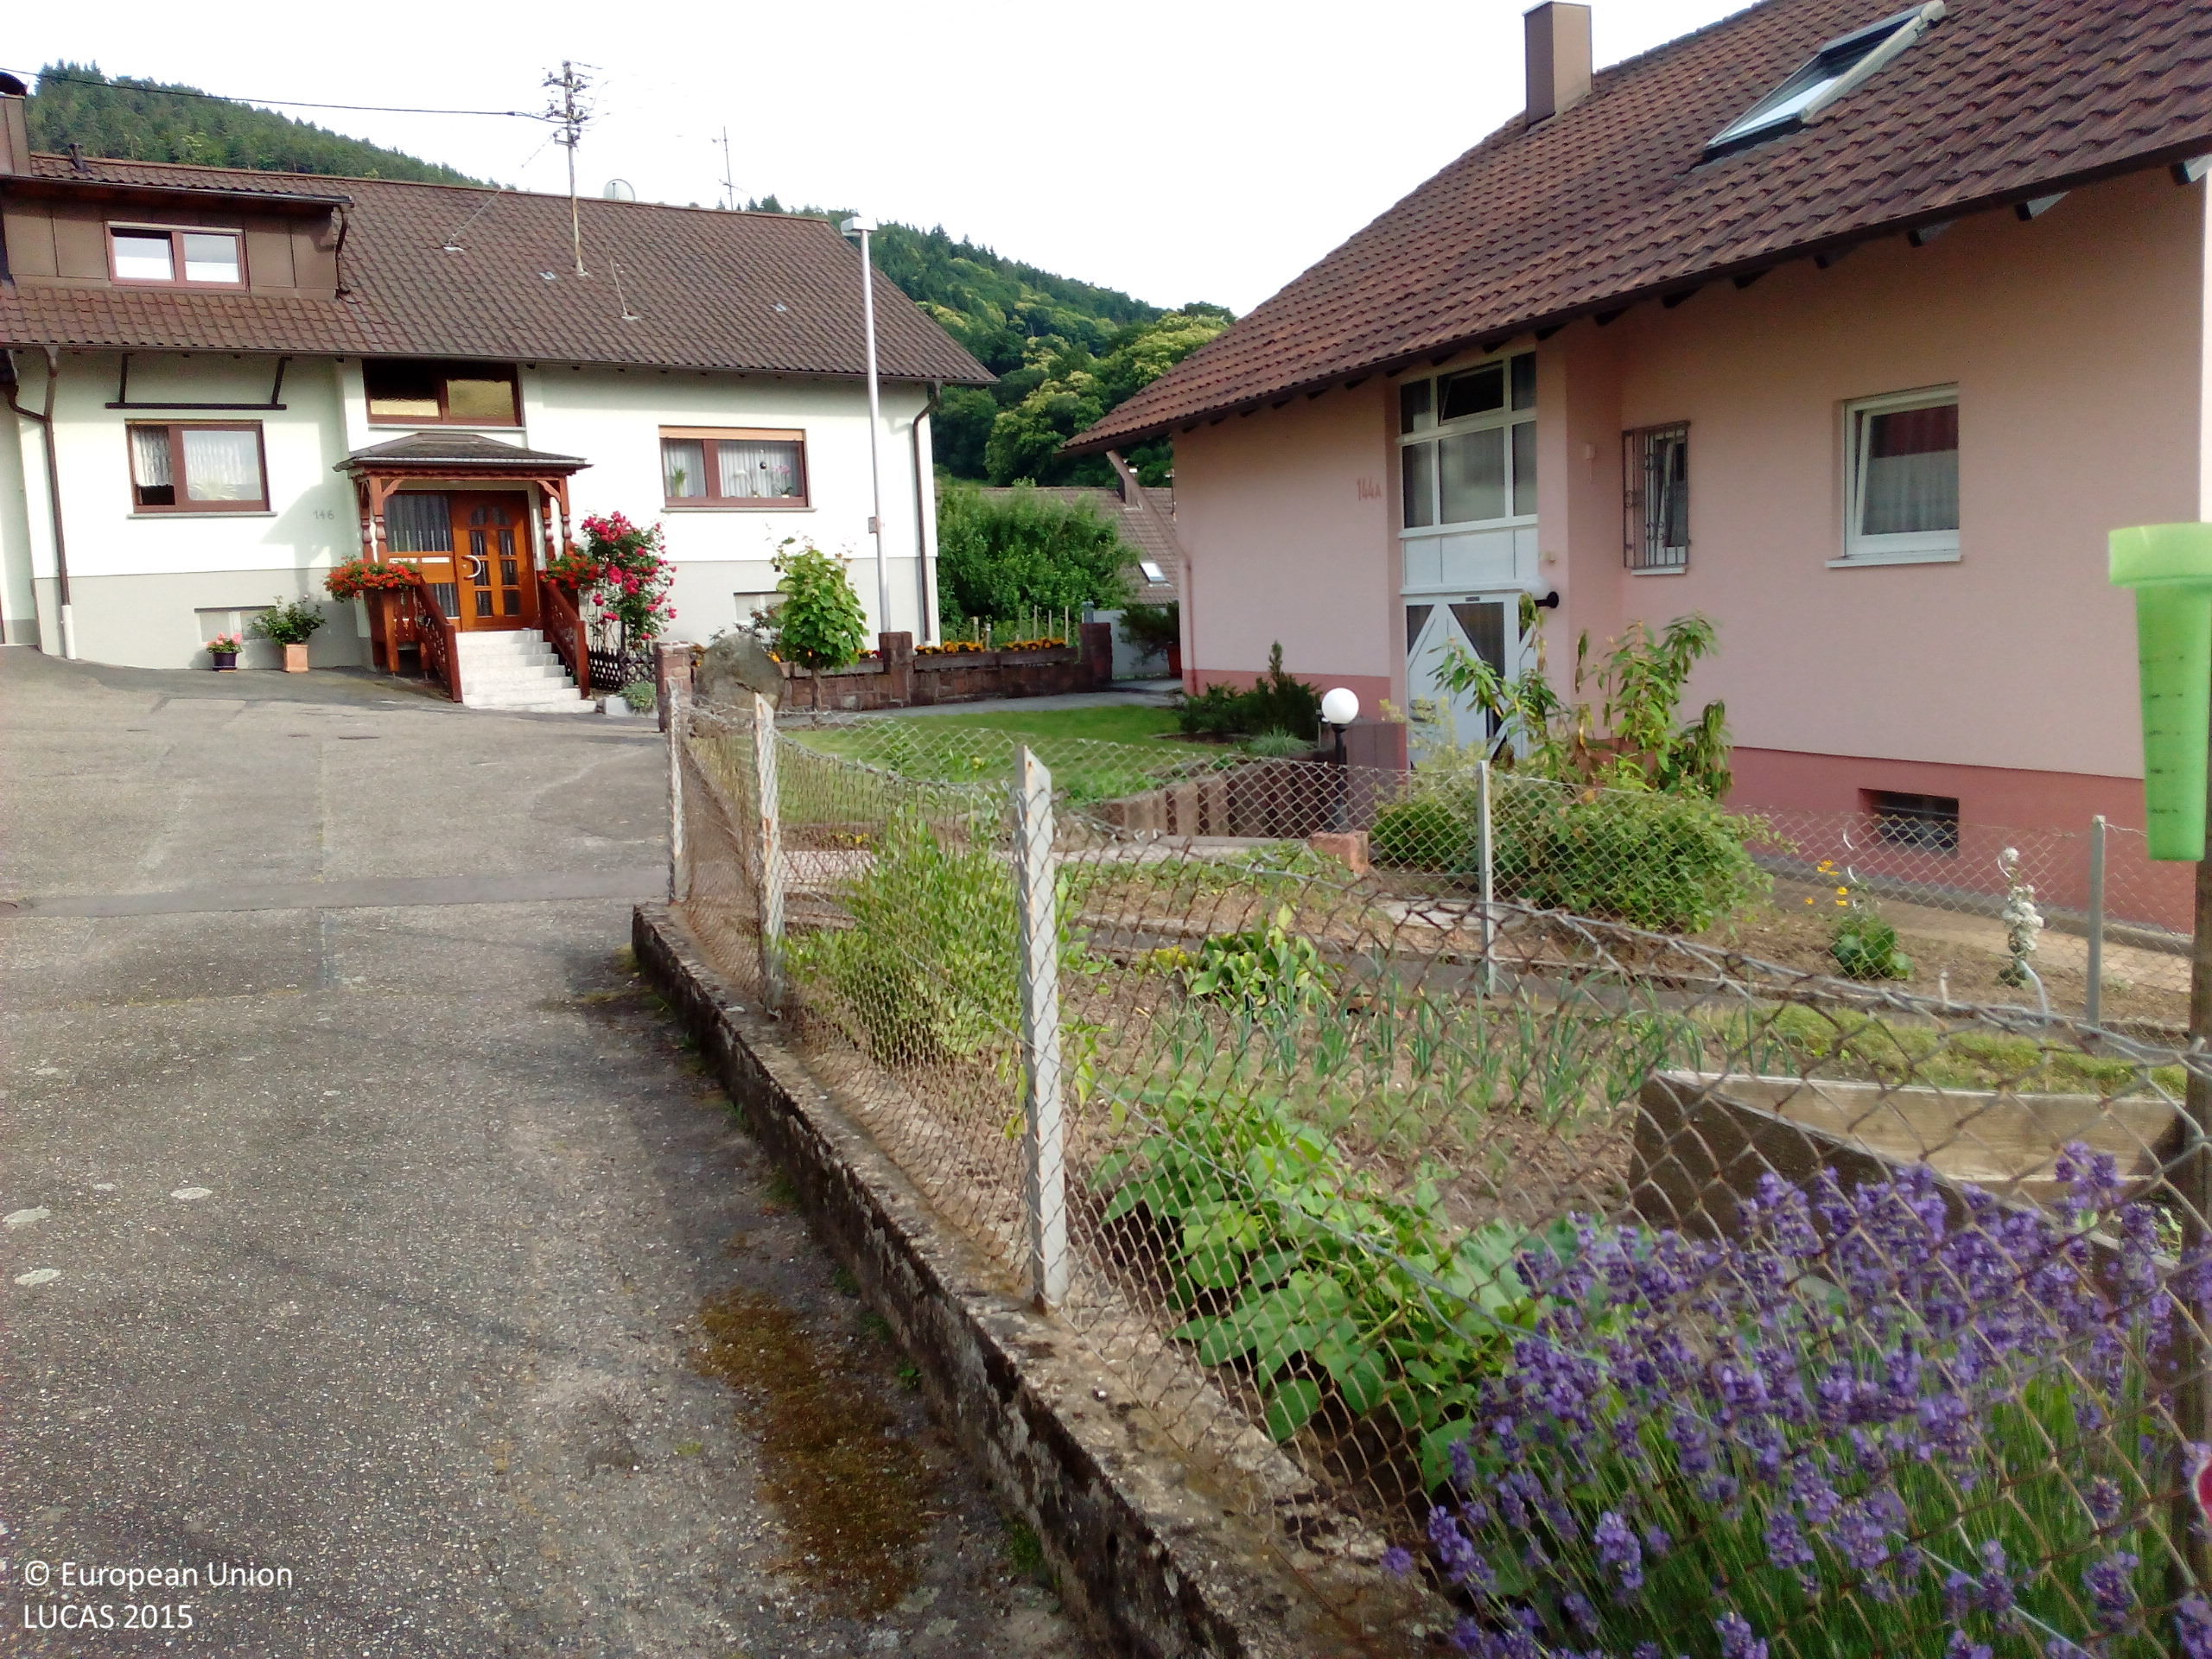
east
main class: Grassland
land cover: Grassland without tree/shrub cover
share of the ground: > 75 %
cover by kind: herbaceous plants 100 %
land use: Residential
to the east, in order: Grassland without tree/shrub cover; Artificial constructions in urban areas; Broadleaved woodland; Paved roads, cycling and walking lanes; Vineyards
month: June
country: DE
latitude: 48.7122
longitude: 8.1660
